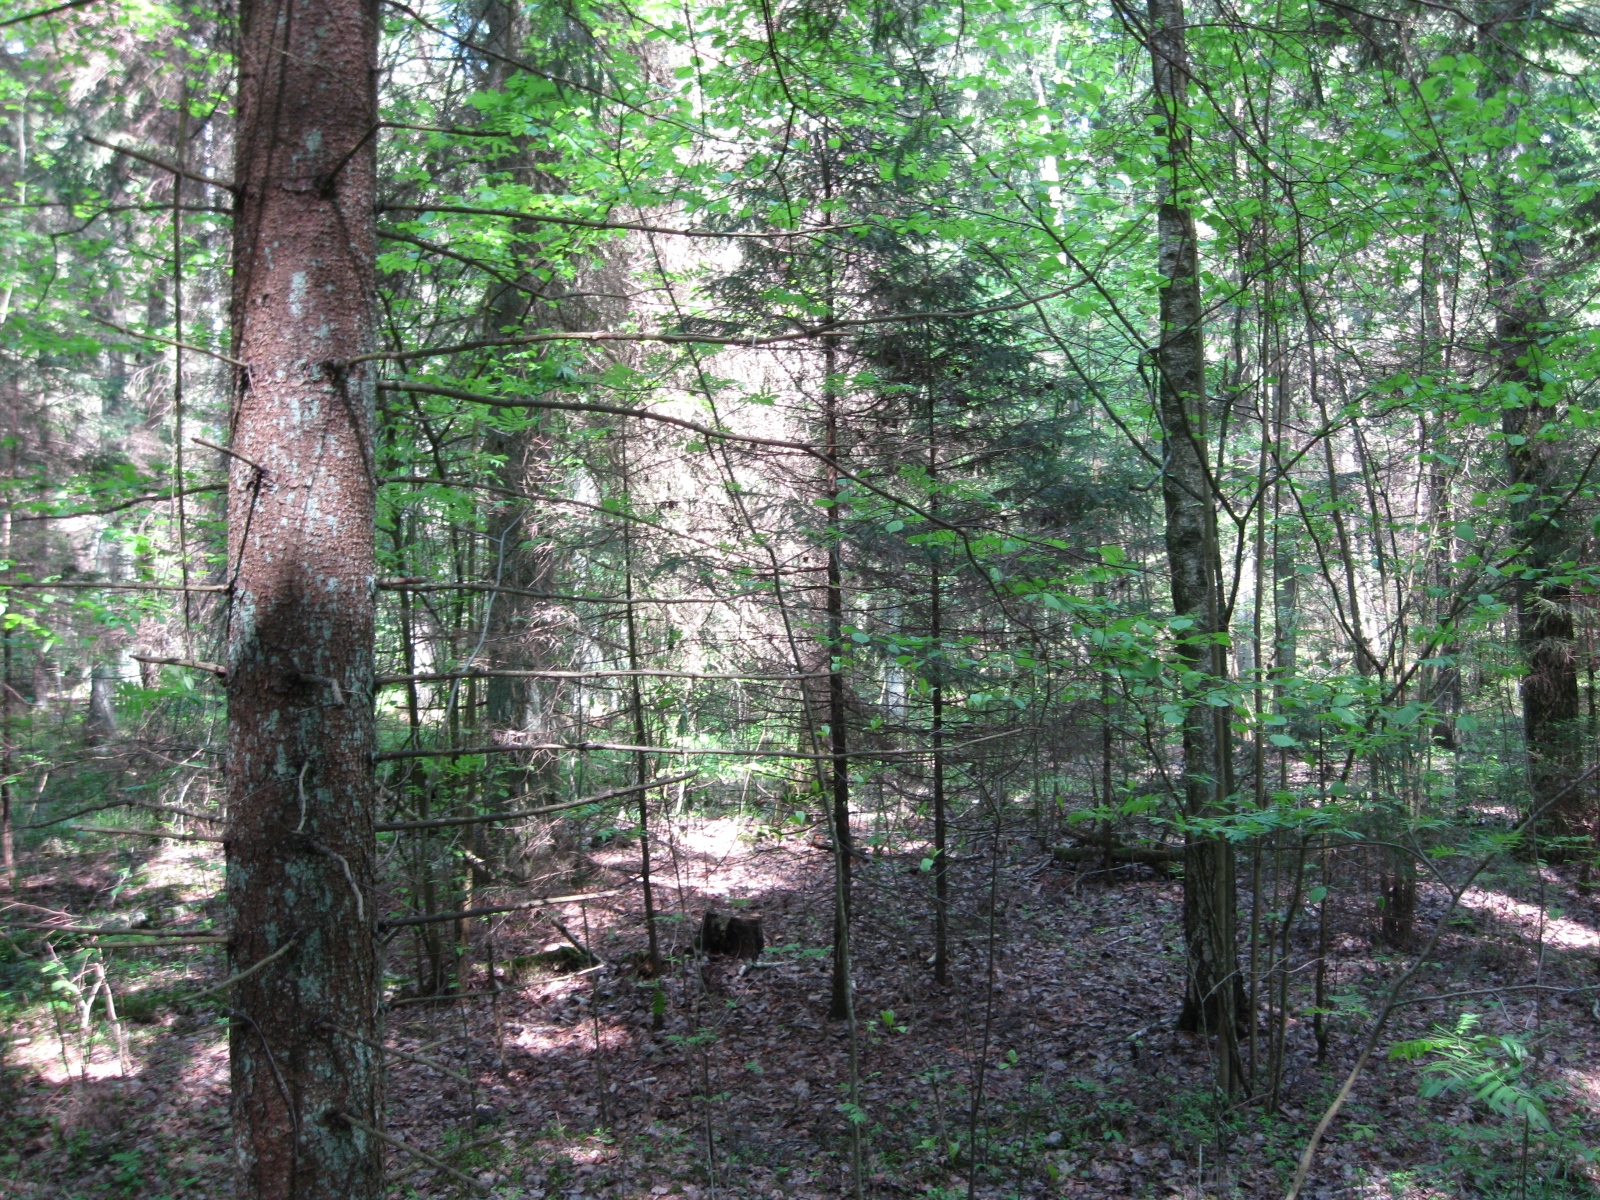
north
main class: Woodland
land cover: Spruce dominated mixed woodland
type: hemiboreal forest and nemoral coniferous forest and mixed broadleaved-coniferous forest
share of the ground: > 75 %
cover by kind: coniferous forest trees 50 %, broadleaved forest trees 45 %, lichens and mosses 5 %
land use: Forestry
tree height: > 5 m
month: May
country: LT
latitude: 56.0047
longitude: 24.1219
